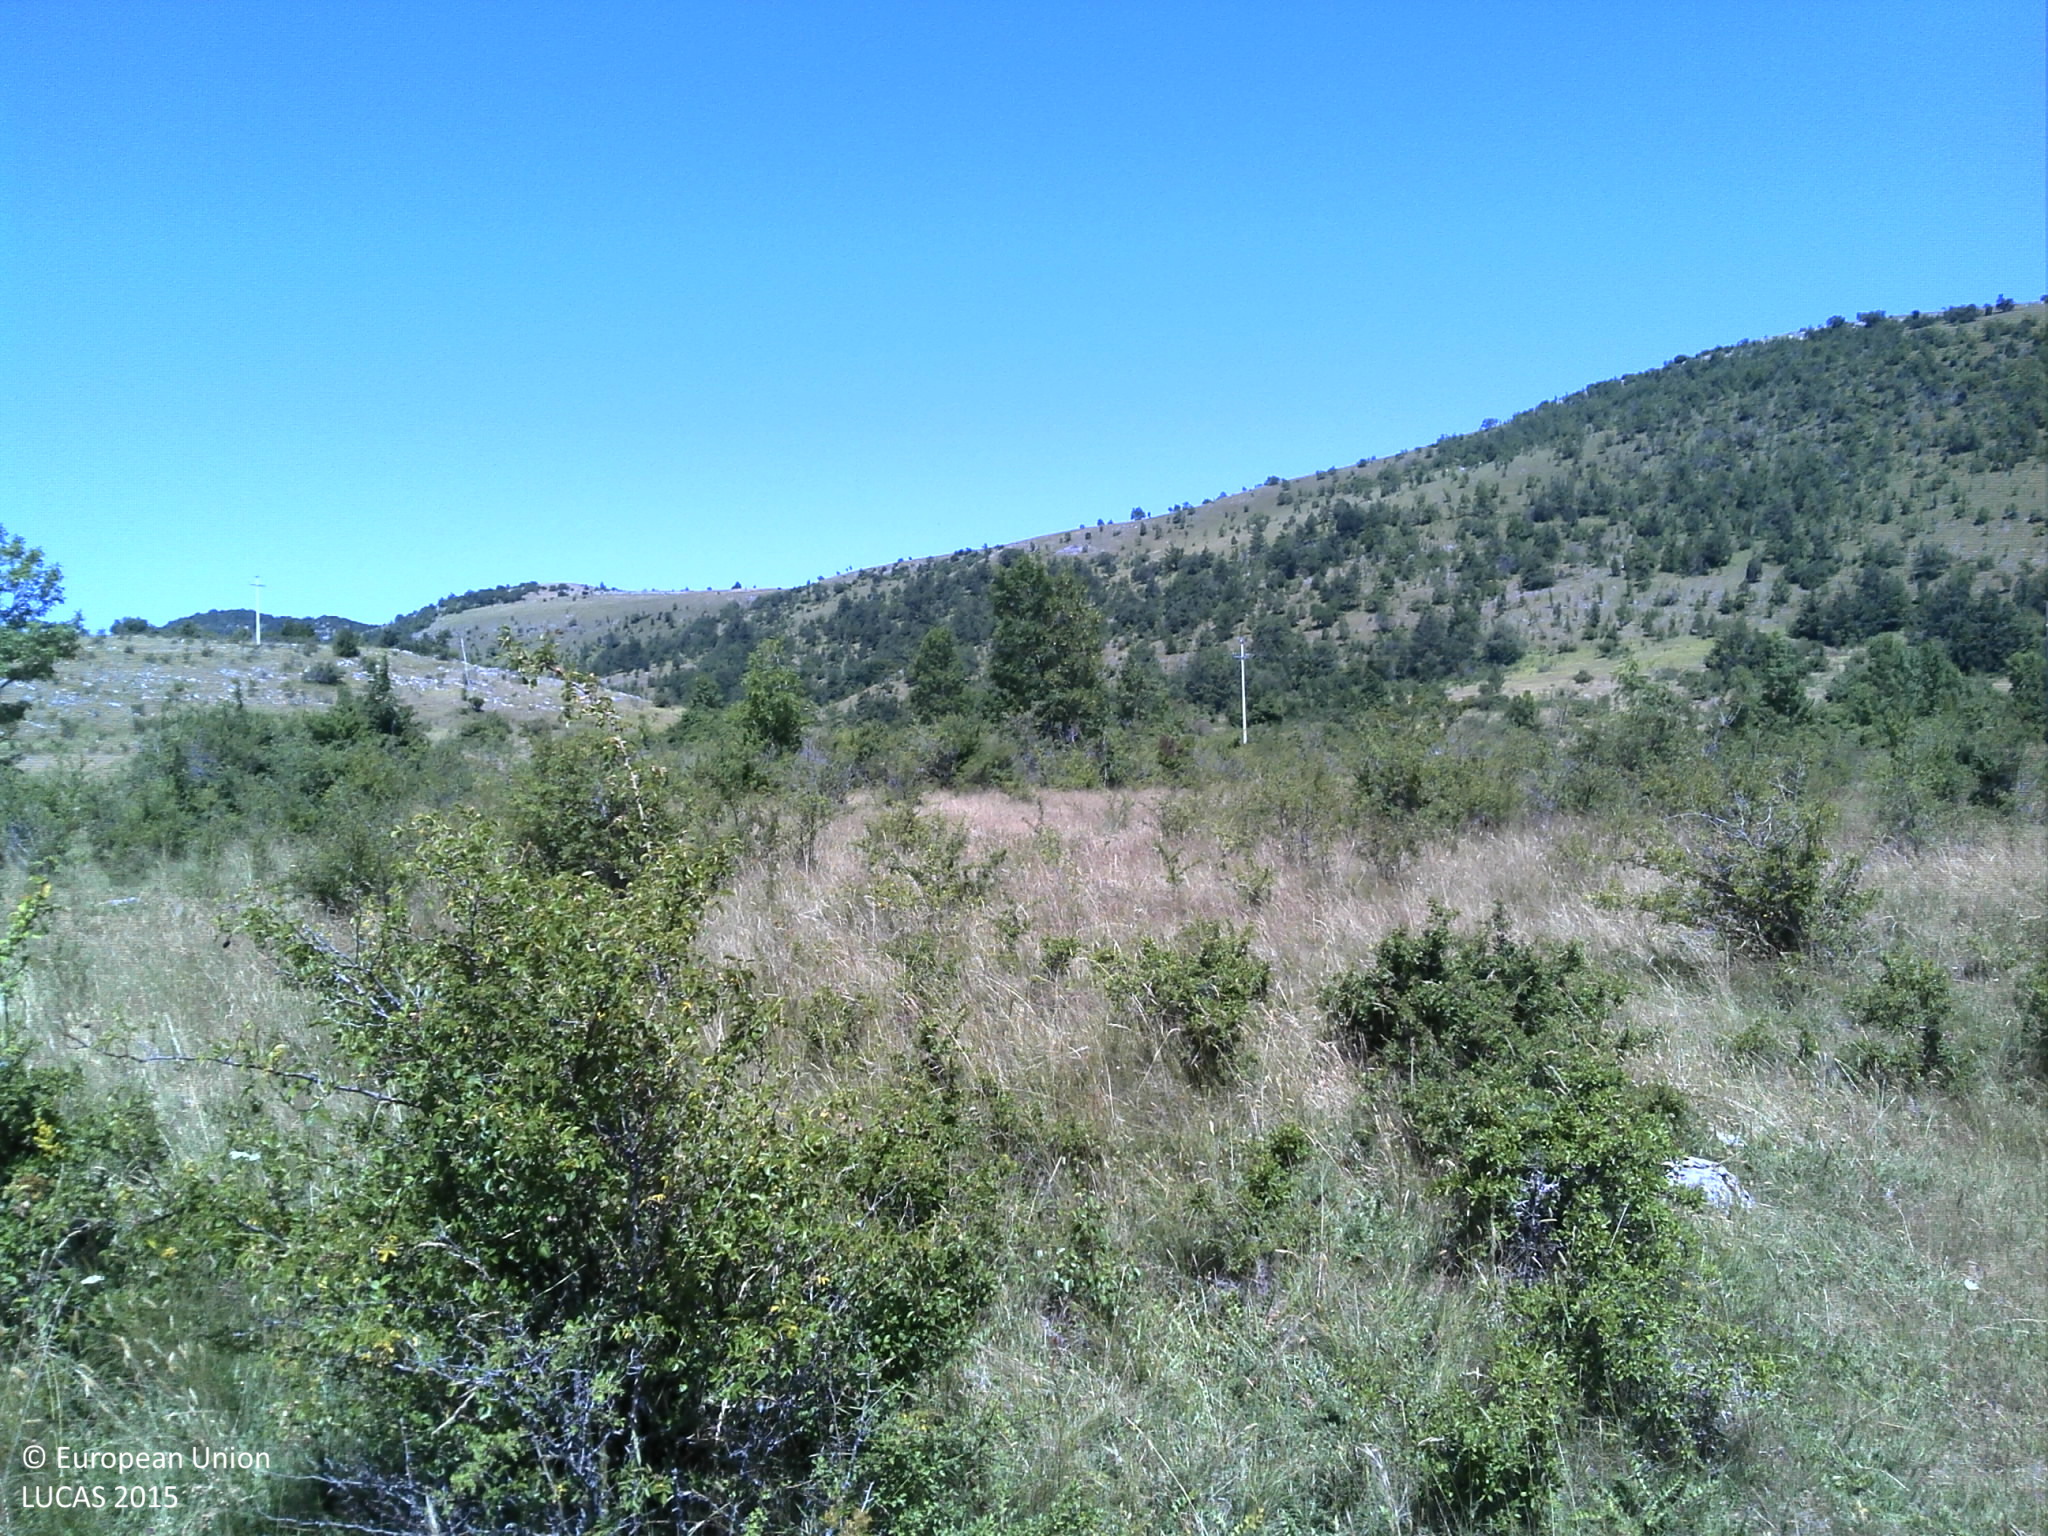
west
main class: Shrubland
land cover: Shrubland with sparse tree cover
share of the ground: 25 - 50 %
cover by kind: herbaceous plants 55 %, shrubs 40 %, broadleaved forest trees 5 %
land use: Semi-natural and natural areas not in use
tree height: < 5 m
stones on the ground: < 10 %
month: July
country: HR
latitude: 44.4006
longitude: 15.8820
